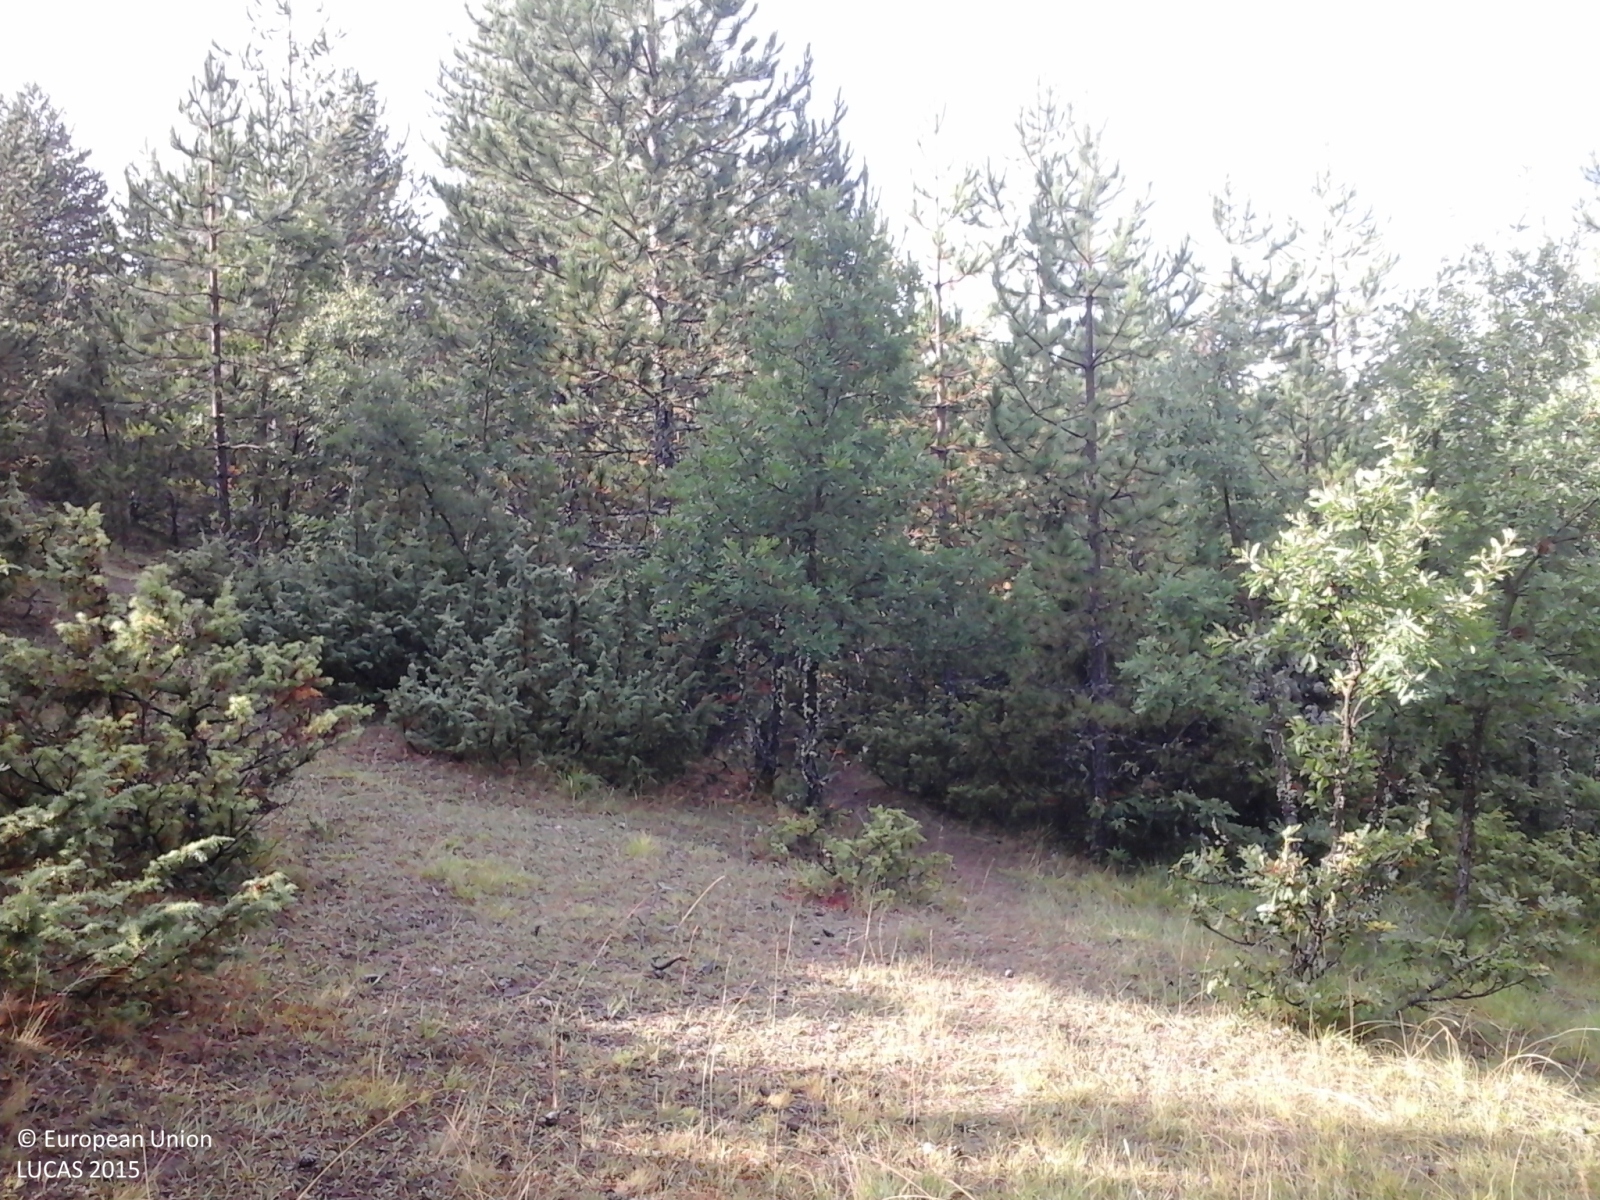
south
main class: Woodland
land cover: Pine dominated mixed woodland
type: coniferous forest of the mediterranean region
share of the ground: 50 - 75 %
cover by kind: coniferous forest trees 45 %, broadleaved forest trees 25 %, herbaceous plants 20 %, shrubs 5 %, unconsolidated bare surface 5 %
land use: Forestry
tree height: > 5 m
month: August
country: GR
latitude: 40.1746
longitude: 21.0116
